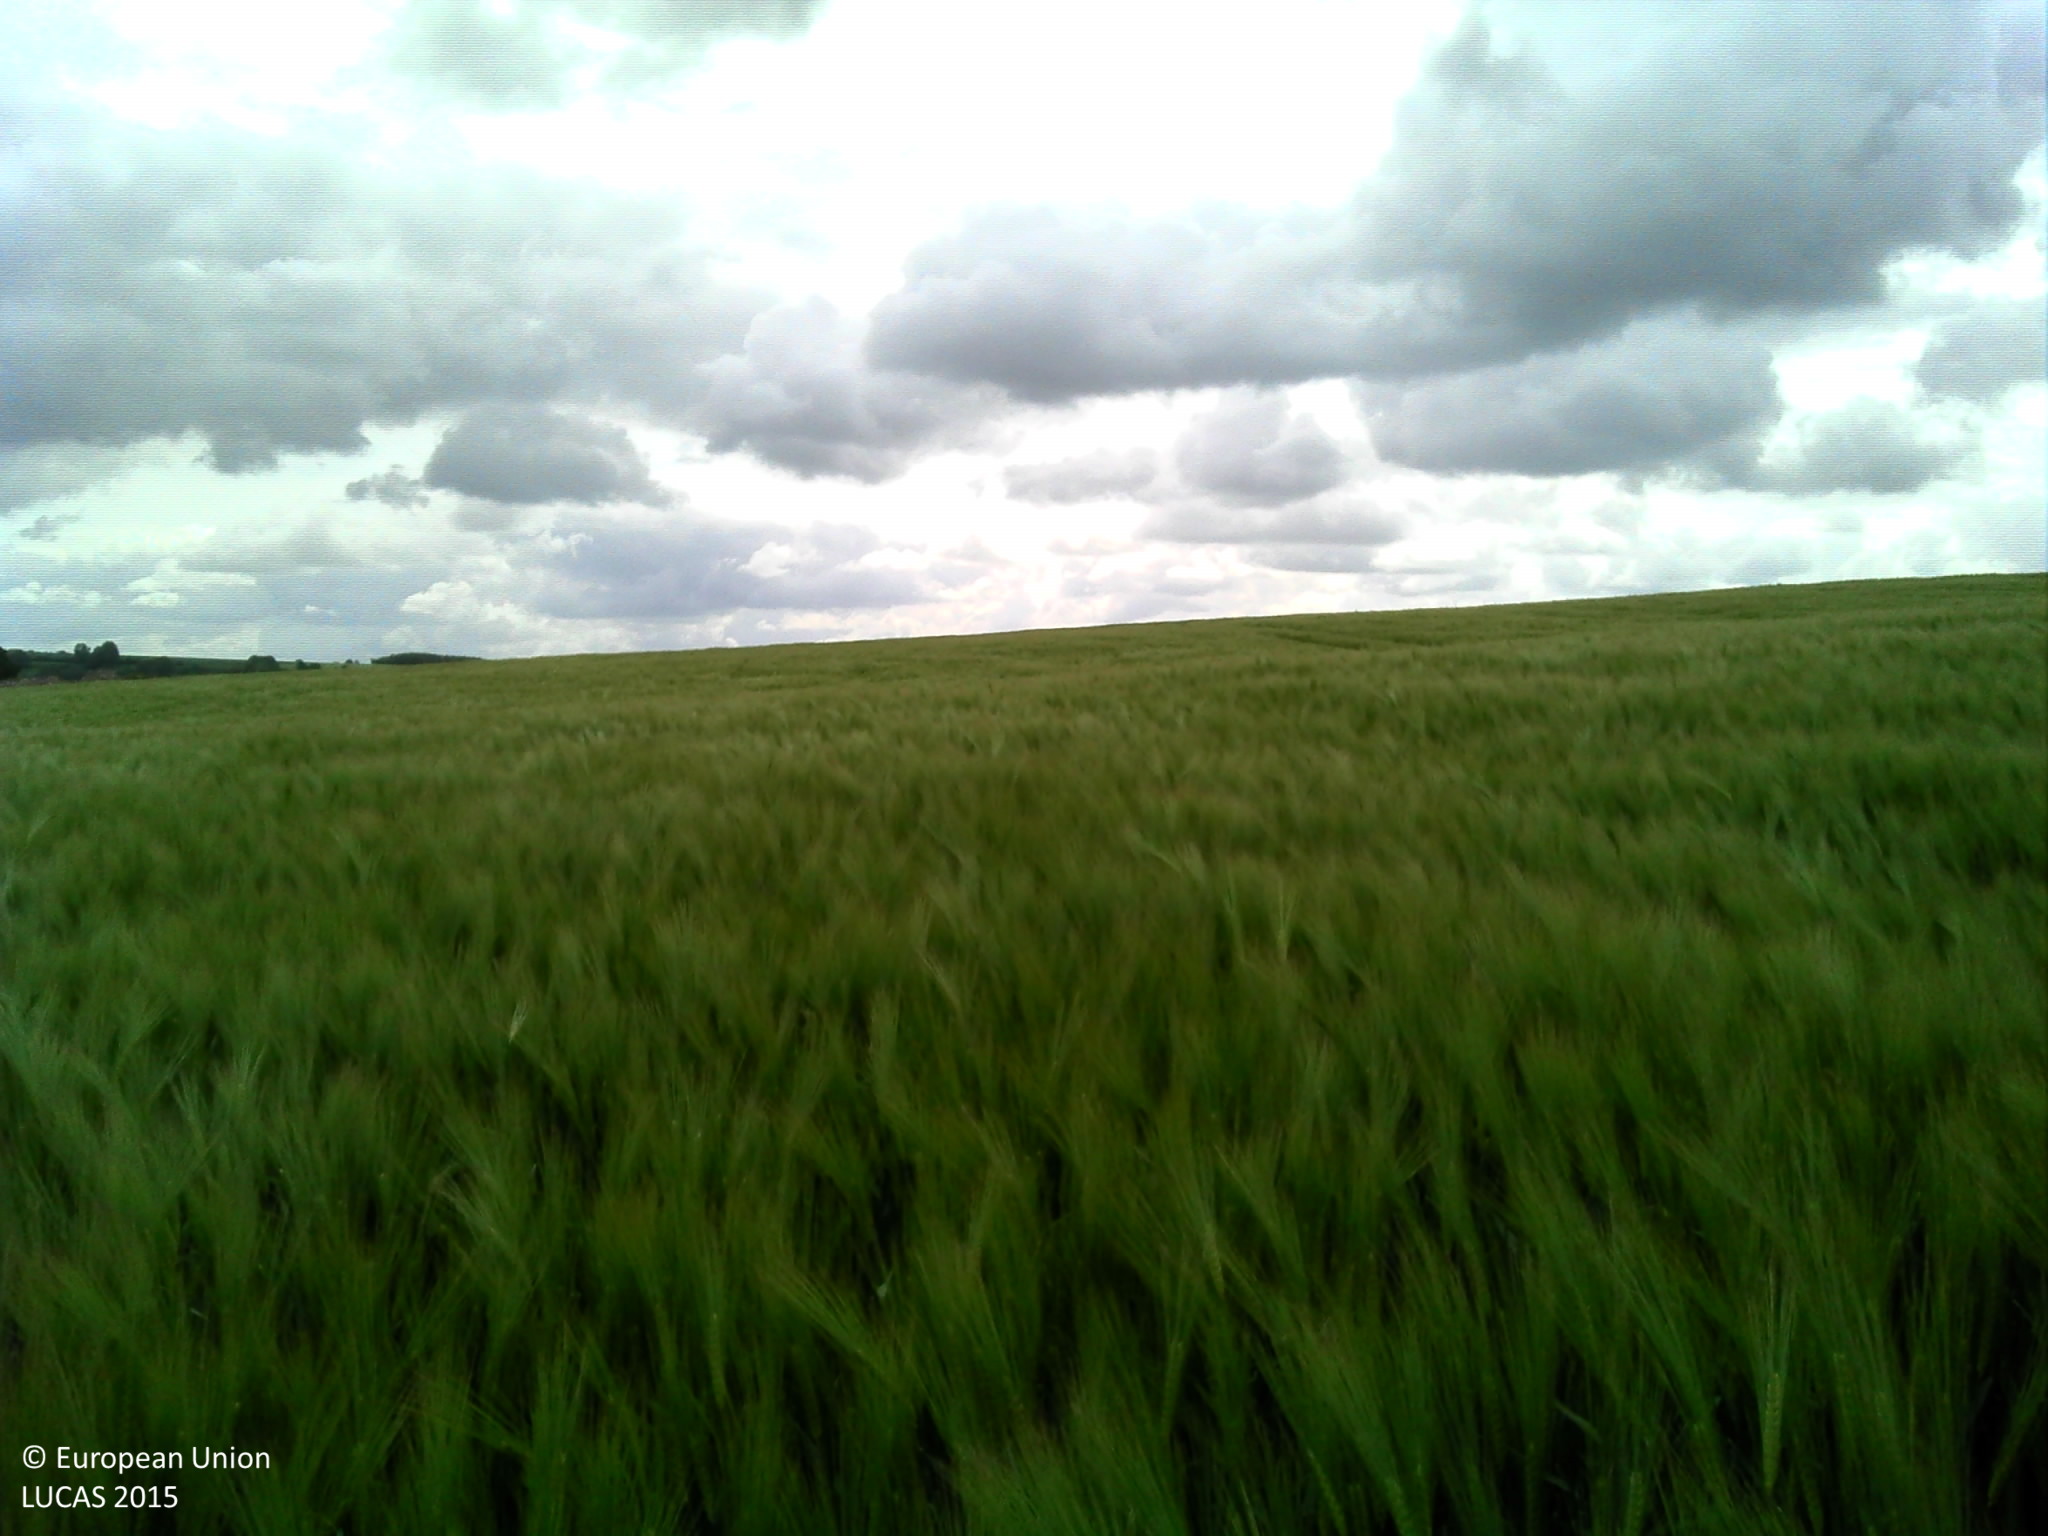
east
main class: Cropland
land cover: Barley
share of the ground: > 75 %
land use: Agriculture (excluding fallow land and kitchen gardens)
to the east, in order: Barley; Sugar beet
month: May
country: FR
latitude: 50.5102
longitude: 2.1590
